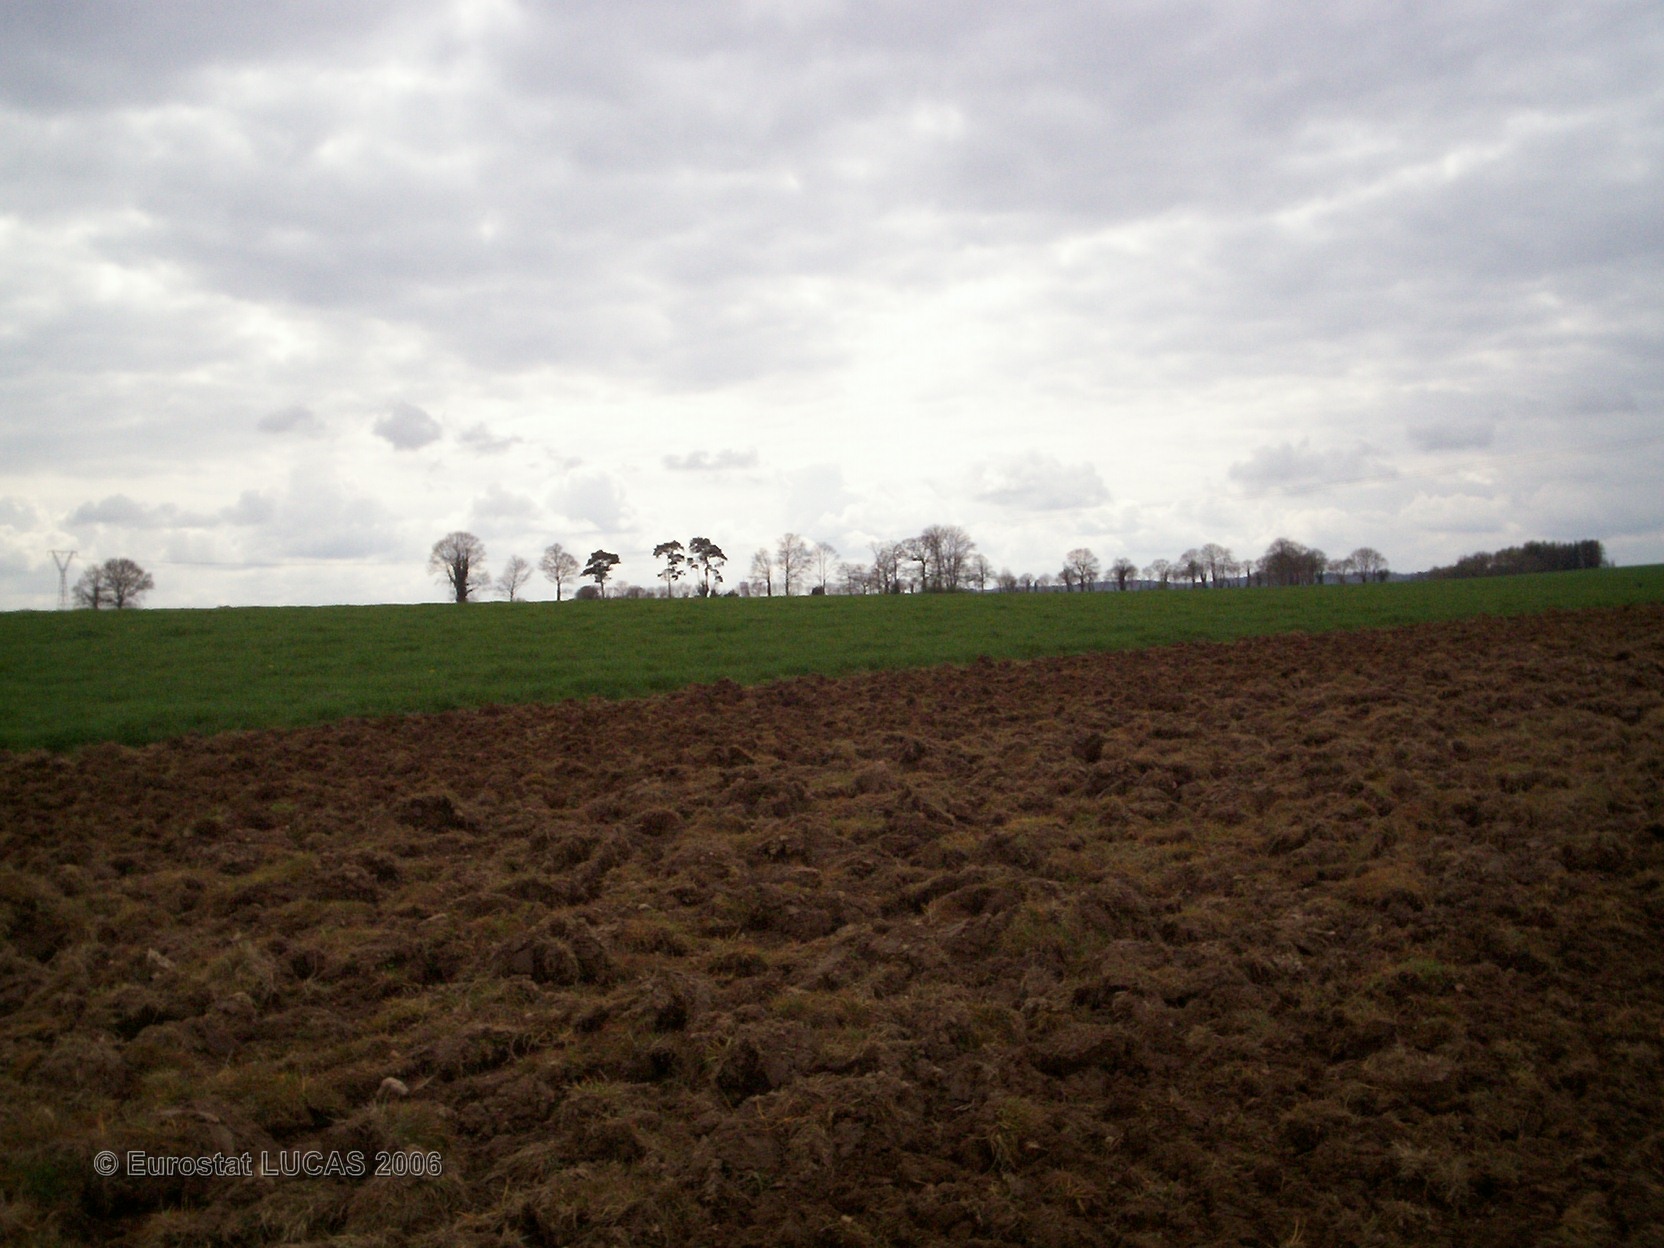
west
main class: Cropland
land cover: Dry pulses
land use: Agriculture (excluding fallow land and kitchen gardens)
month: May
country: FR
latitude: 48.0943
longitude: -2.9438
